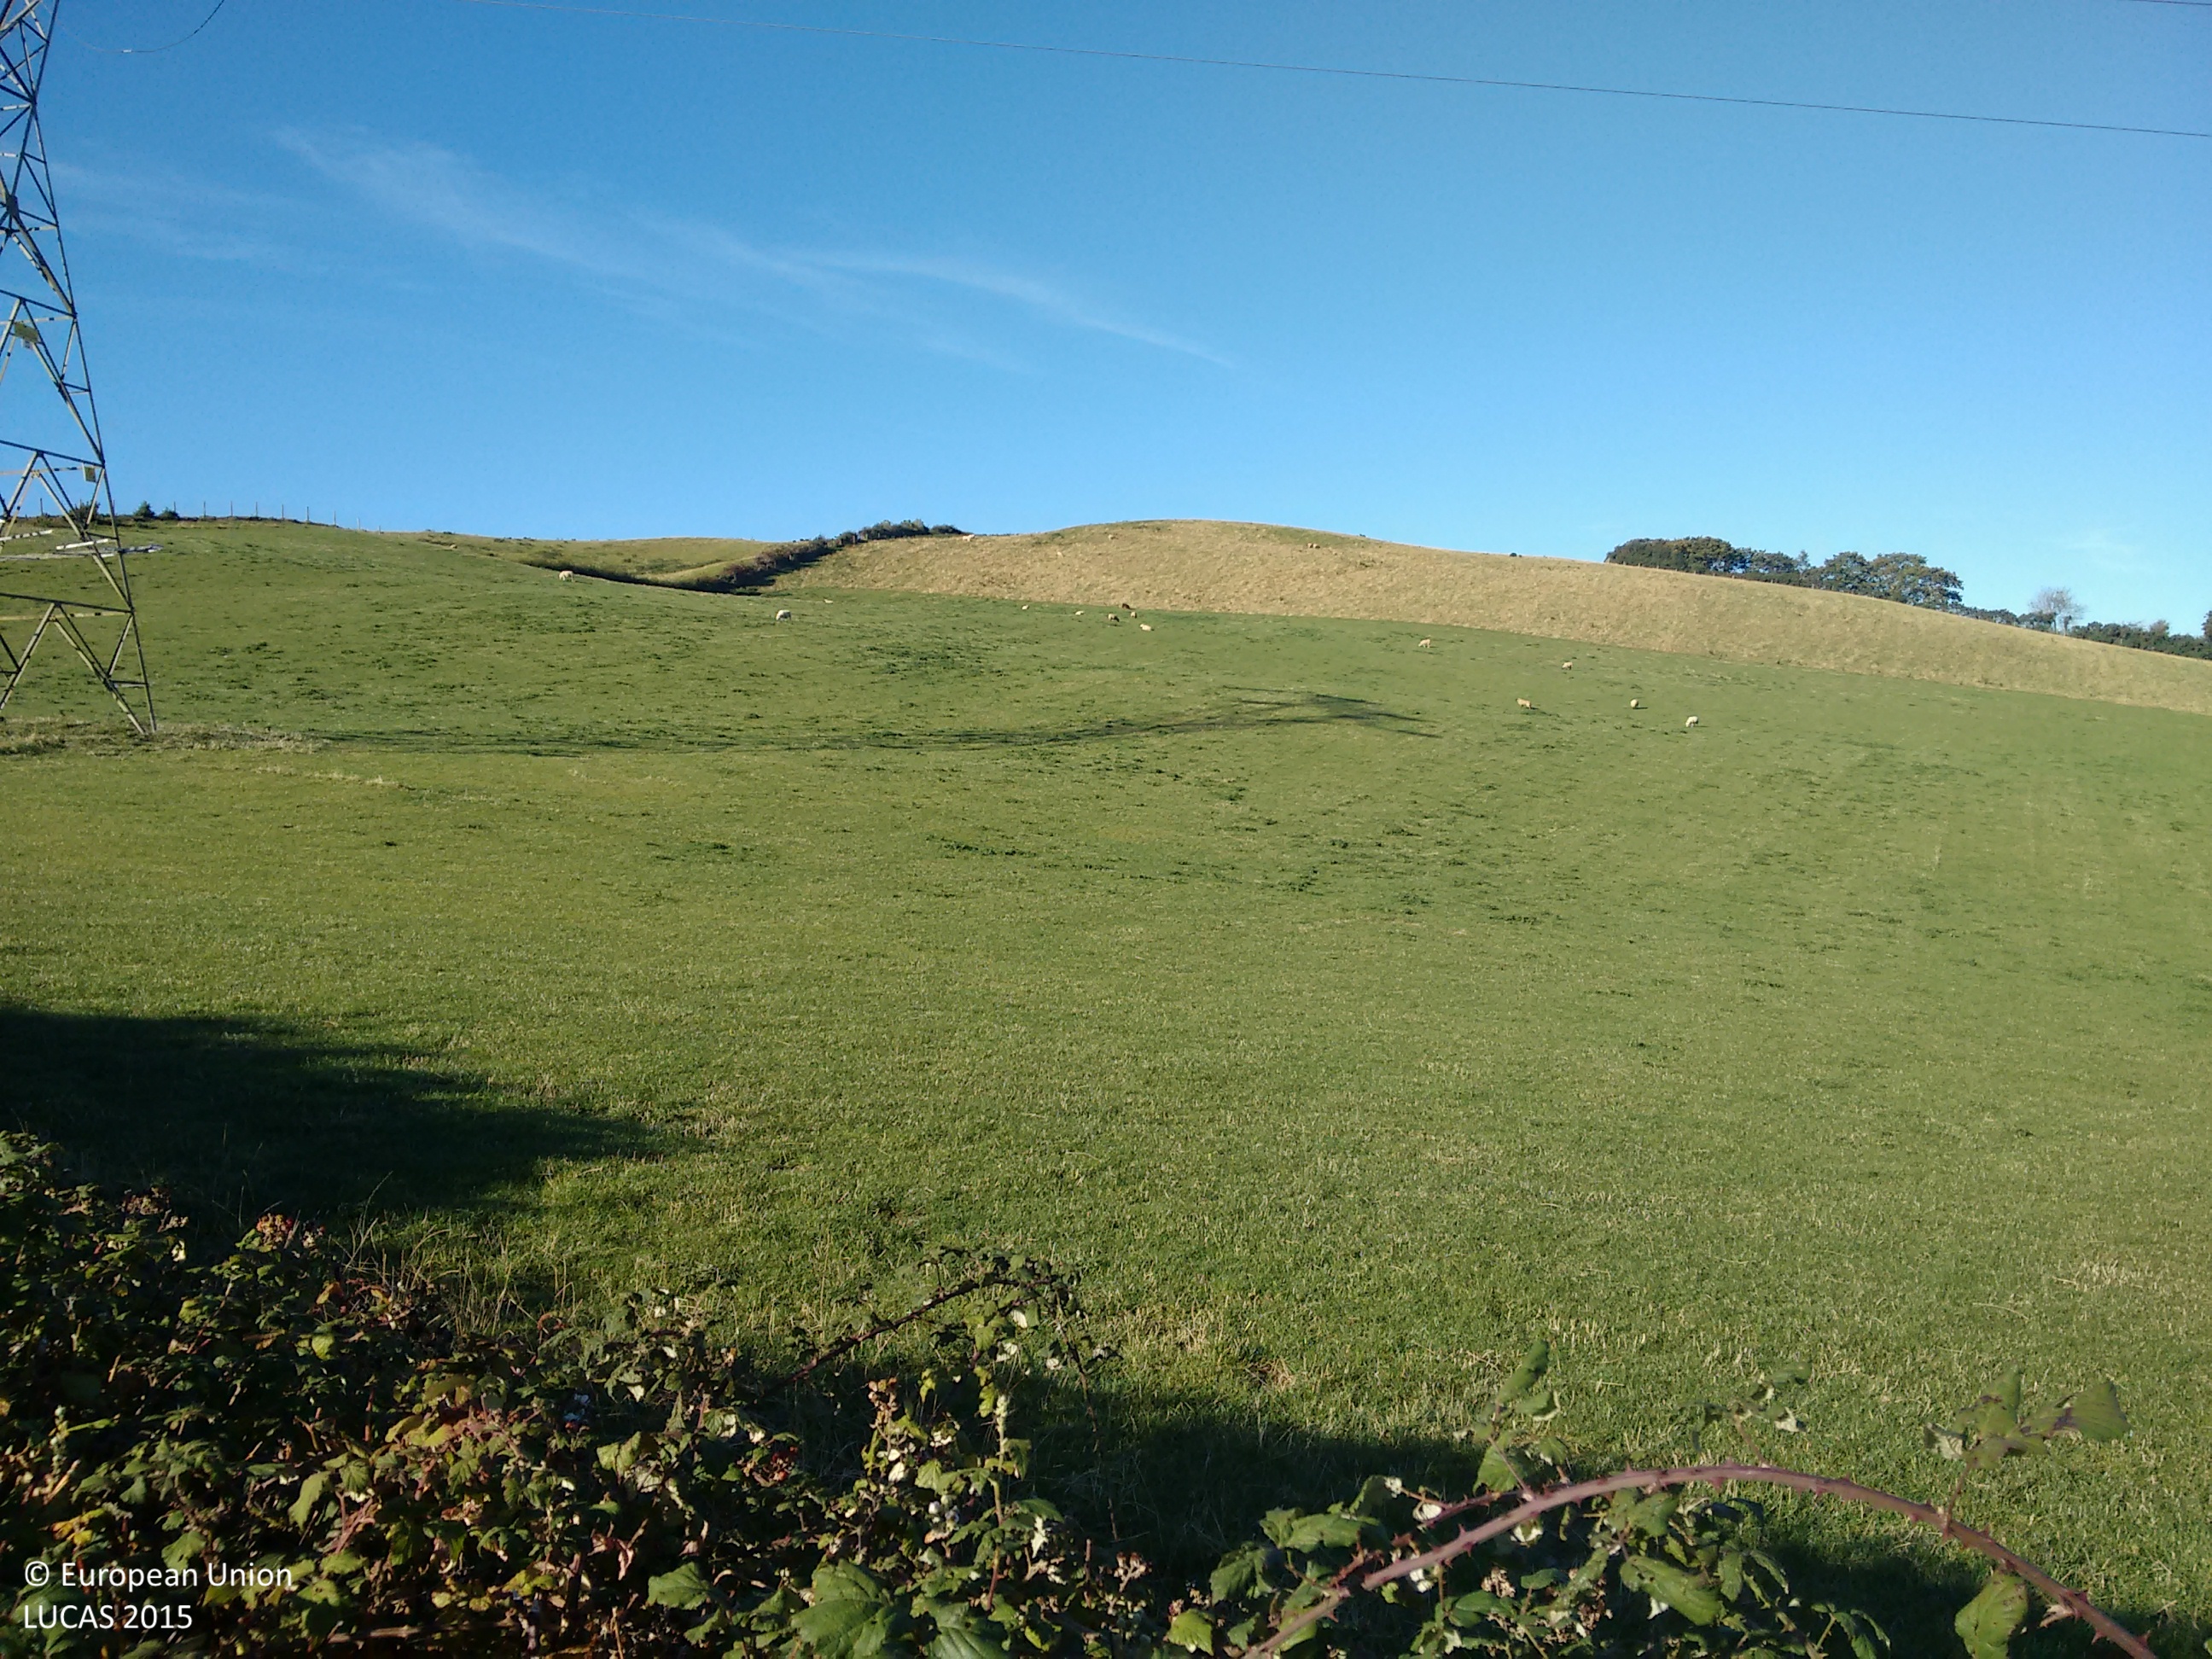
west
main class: Grassland
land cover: Grassland without tree/shrub cover
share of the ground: > 75 %
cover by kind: herbaceous plants 100 %
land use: Agriculture (excluding fallow land and kitchen gardens)
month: October
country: GB
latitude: 52.3955
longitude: -4.0419
